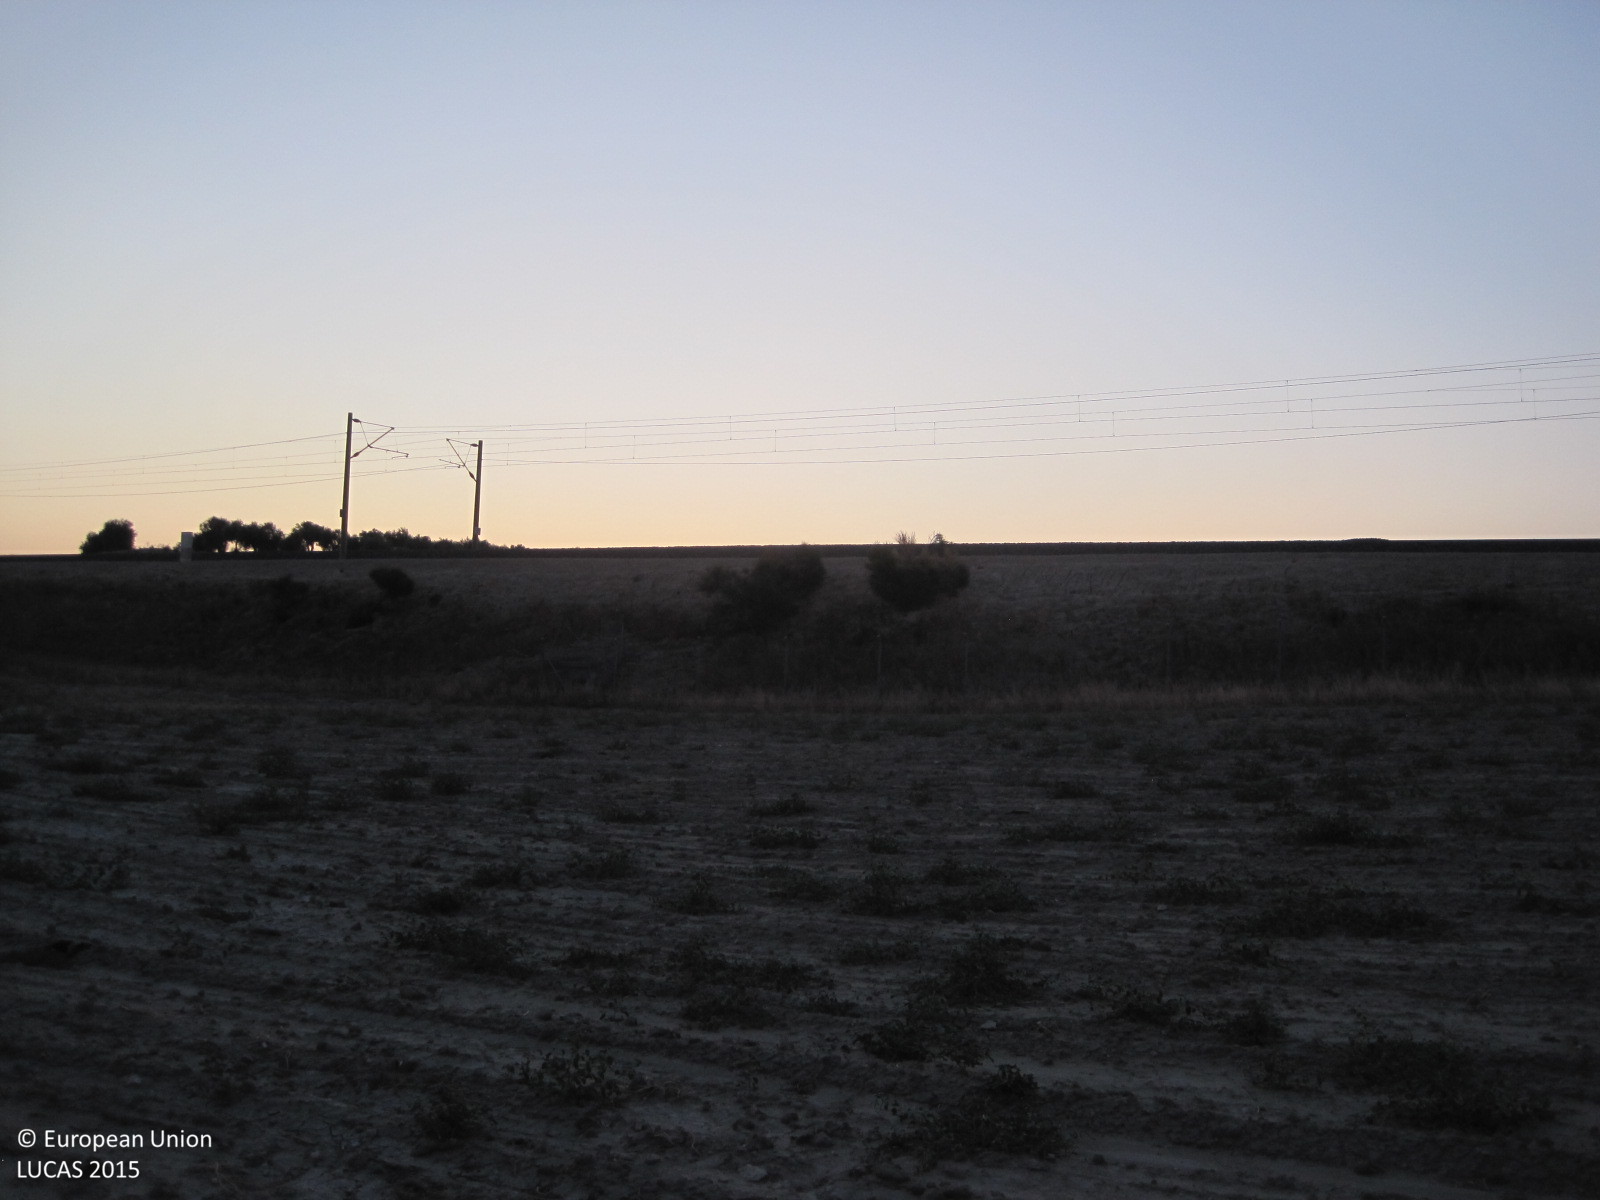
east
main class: Grassland
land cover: Spontaneously vegetated surfaces
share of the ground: 50 - 75 %
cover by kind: herbaceous plants 50 %, unconsolidated bare surface 50 %
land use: Fallow land
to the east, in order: Spontaneously vegetated surfaces; Grass margins; Tracks; Fences; Shrubland without tree cover; Electric lines; Railways; Electric lines; Shruby margins; Grassland without tree/shrub cover; Fences; Grass margins; Tracks; Grassland without tree/shrub cover; Barley; Grass margins; Olive groves
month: July
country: ES
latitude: 40.0942
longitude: -3.7931
